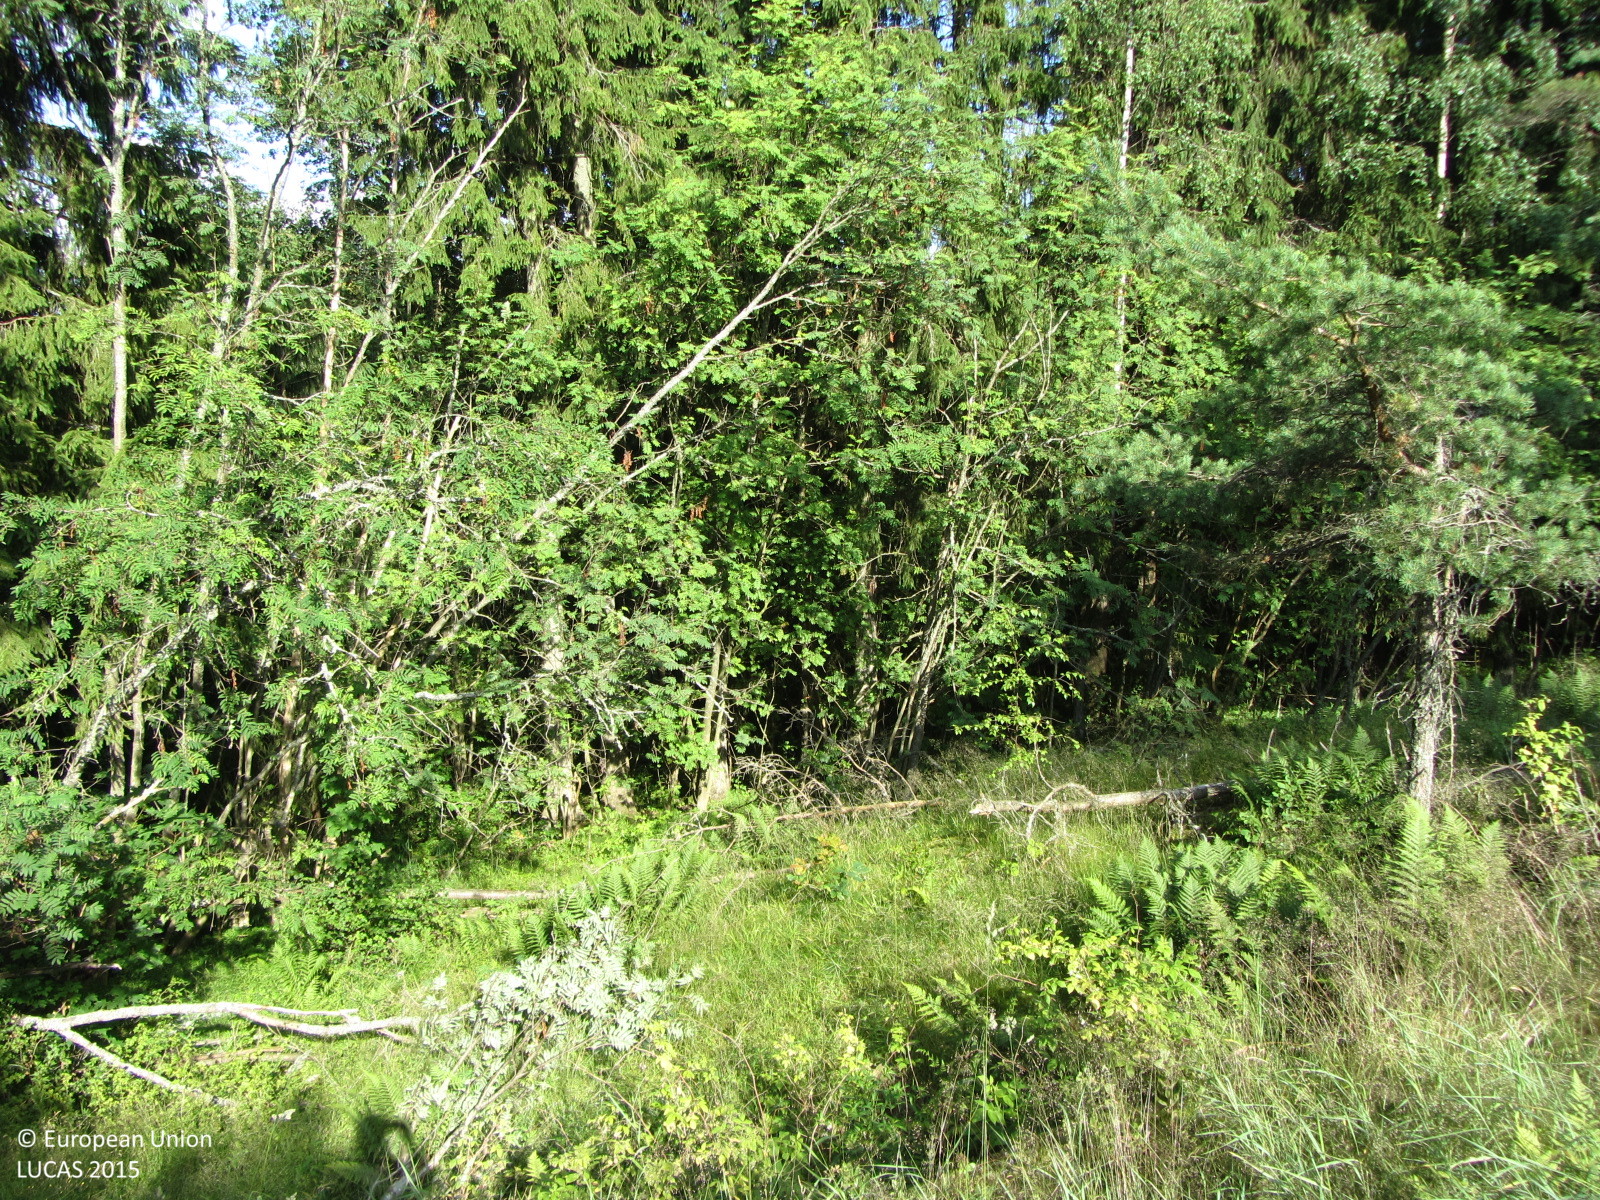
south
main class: Grassland
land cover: Grassland with sparse tree/shrub cover
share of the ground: > 75 %
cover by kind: herbaceous plants 85 %, shrubs 10 %, coniferous forest trees 5 %
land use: Residential
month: July
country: FI
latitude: 60.0963
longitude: 24.4032
